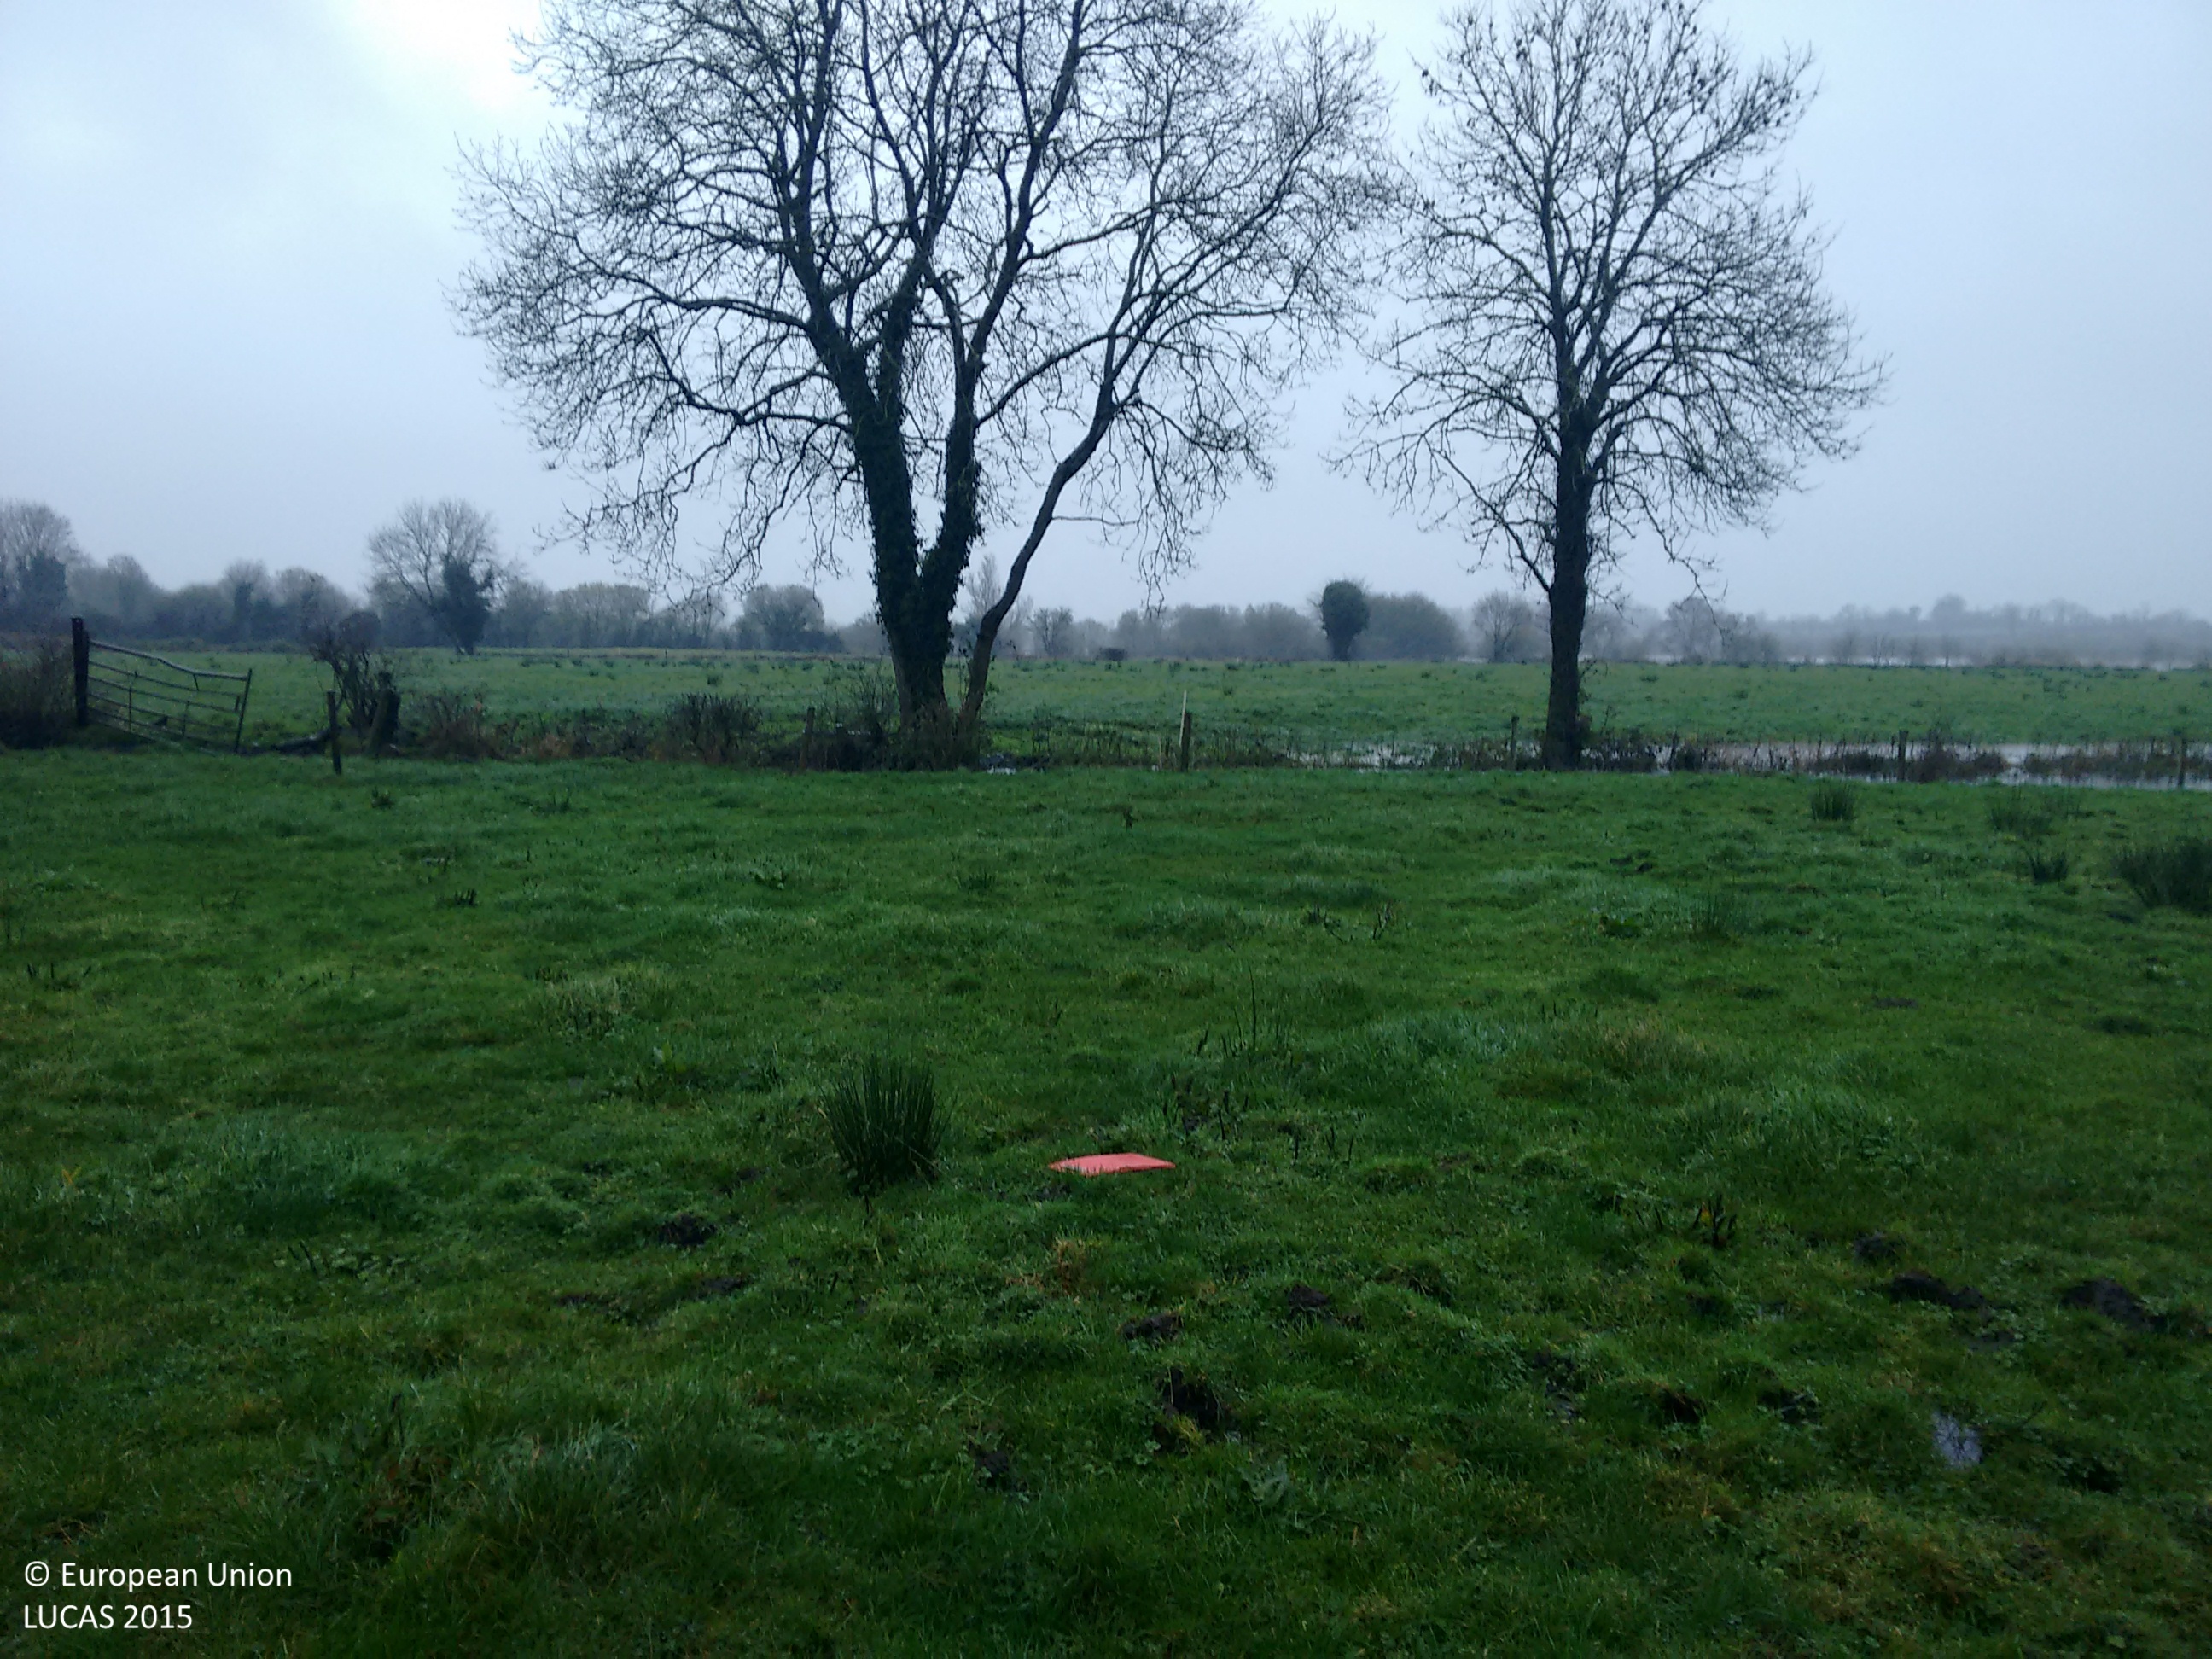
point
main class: Grassland
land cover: Grassland without tree/shrub cover
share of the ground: > 75 %
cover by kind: herbaceous plants 95 %
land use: Agriculture (excluding fallow land and kitchen gardens)
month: November
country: IE
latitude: 53.8494
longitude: -7.8477
